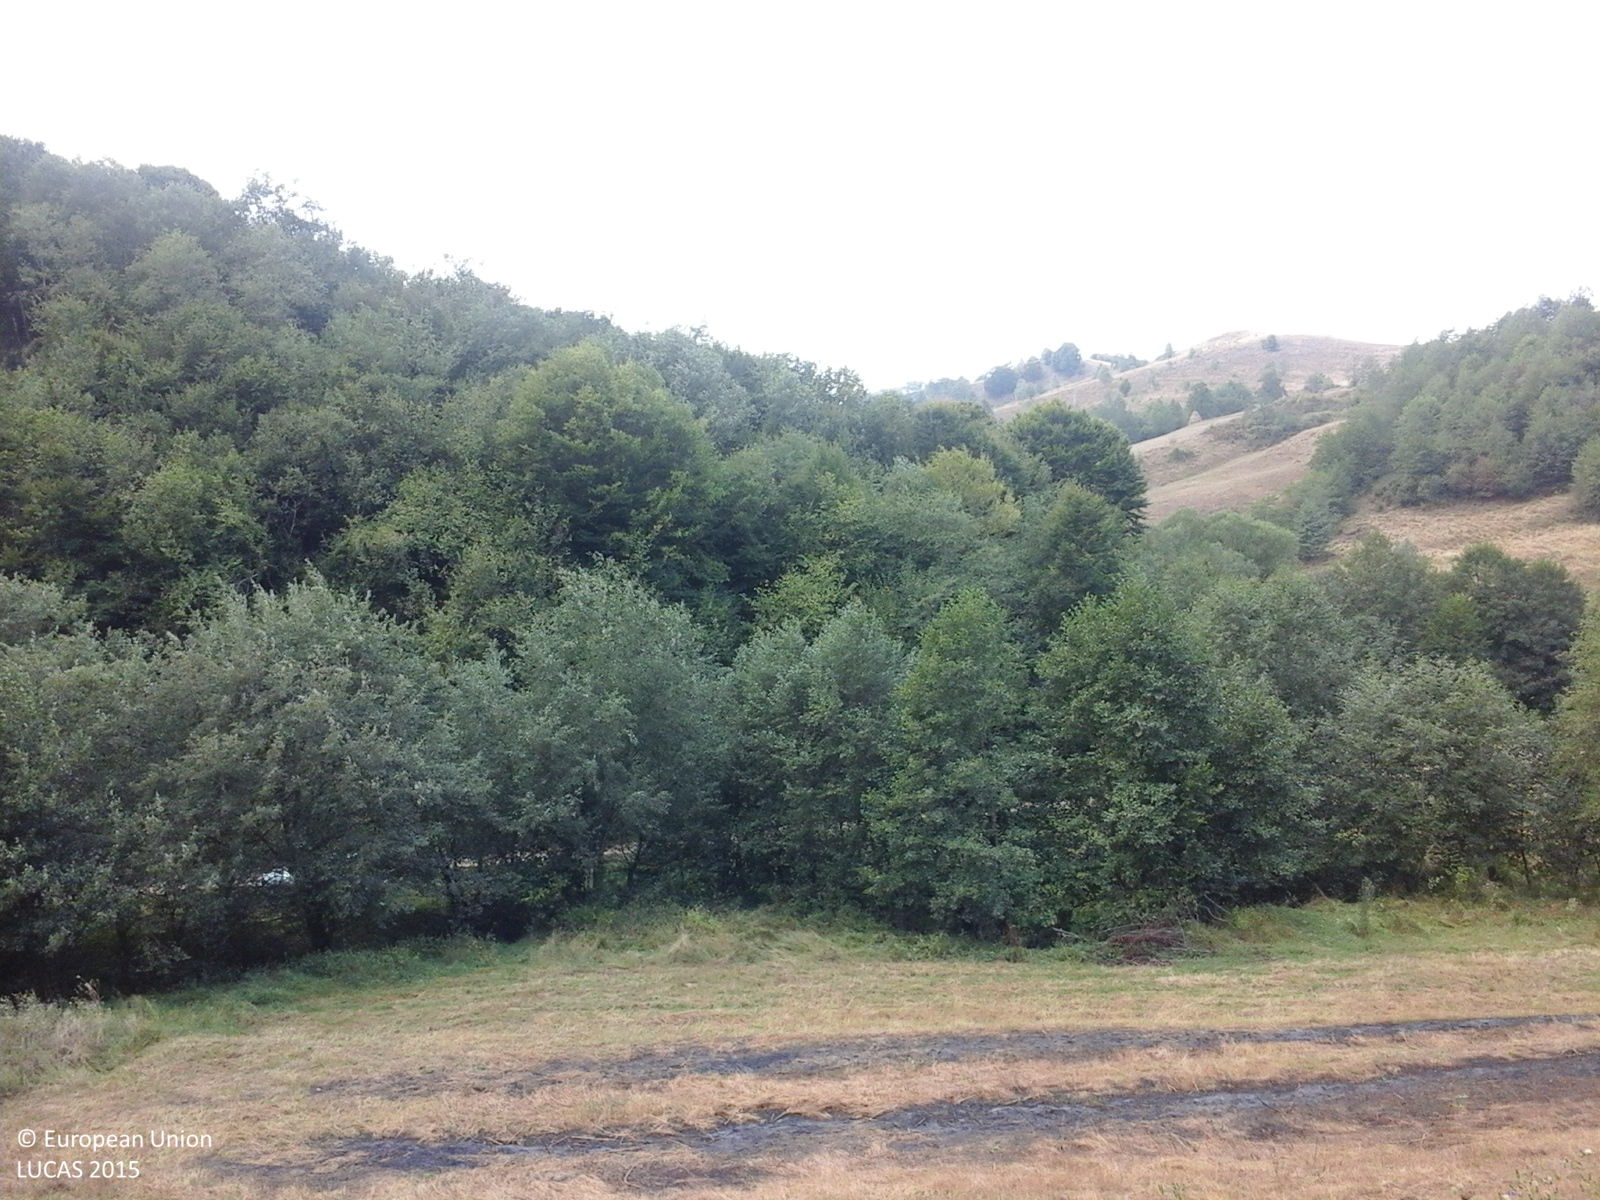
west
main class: Grassland
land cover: Grassland with sparse tree/shrub cover
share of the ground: > 75 %
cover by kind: herbaceous plants 90 %, broadleaved forest trees 5 %, shrubs 5 %
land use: Agriculture (excluding fallow land and kitchen gardens)
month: September
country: RO
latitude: 47.4421
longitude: 23.9391
